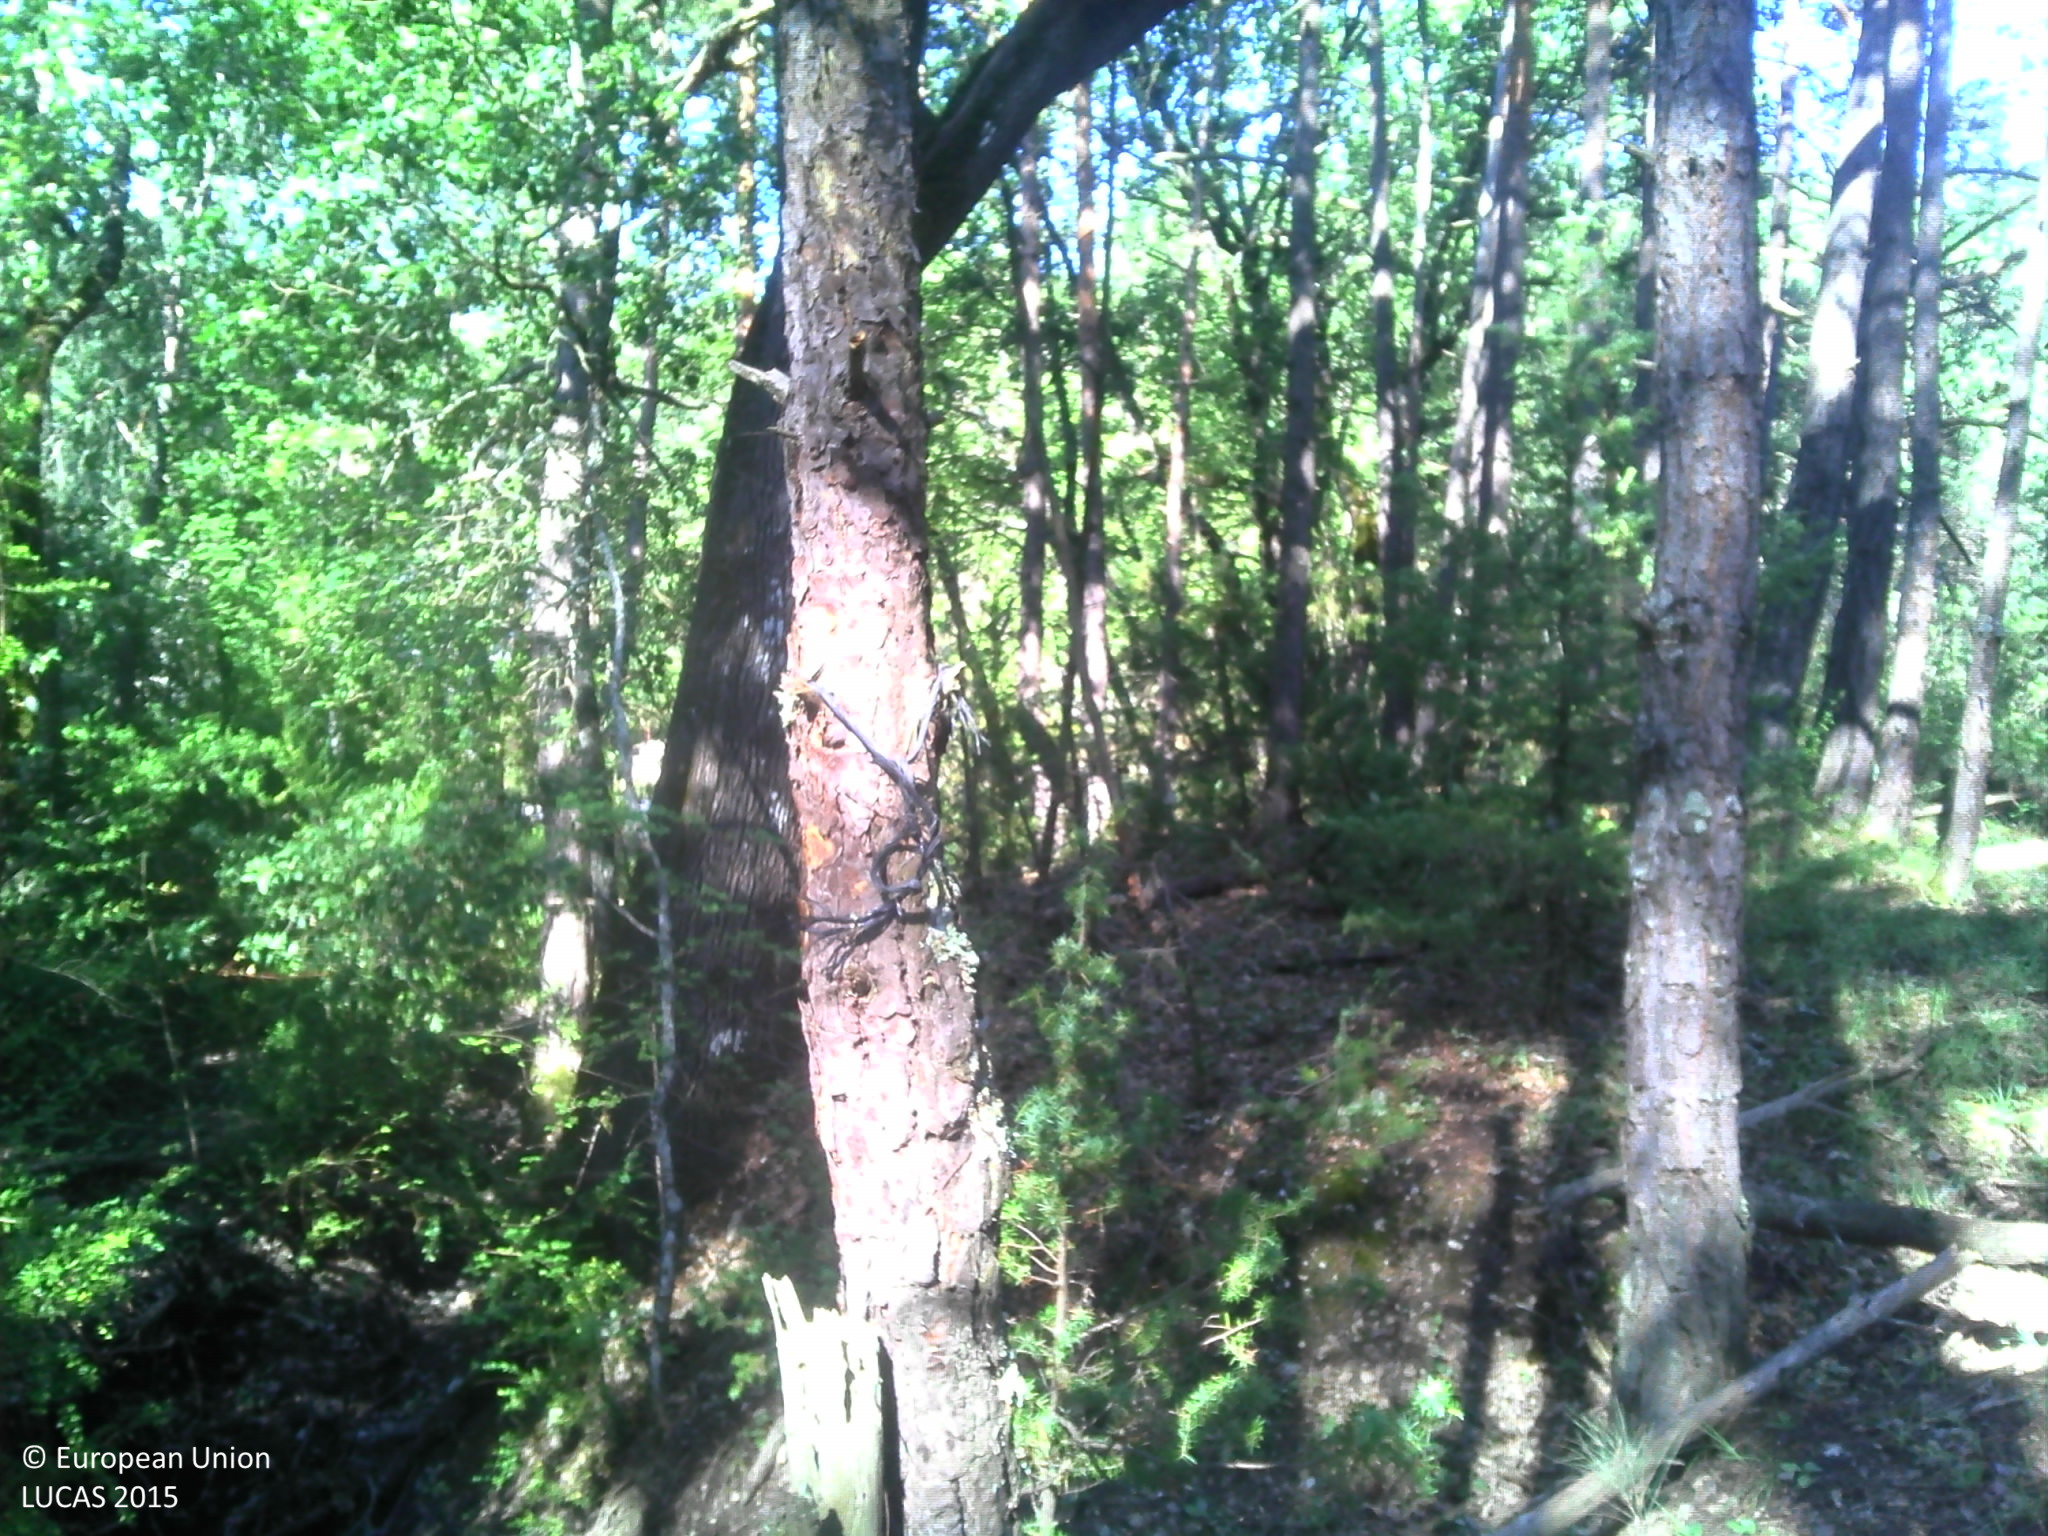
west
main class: Woodland
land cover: Pine dominated mixed woodland
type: alpine coniferous forest
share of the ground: > 75 %
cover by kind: coniferous forest trees 40 %, broadleaved forest trees 20 %, shrubs 20 %, herbaceous plants 20 %
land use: Forestry
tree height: > 5 m
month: August
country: FR
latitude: 44.1391
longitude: 6.2698
